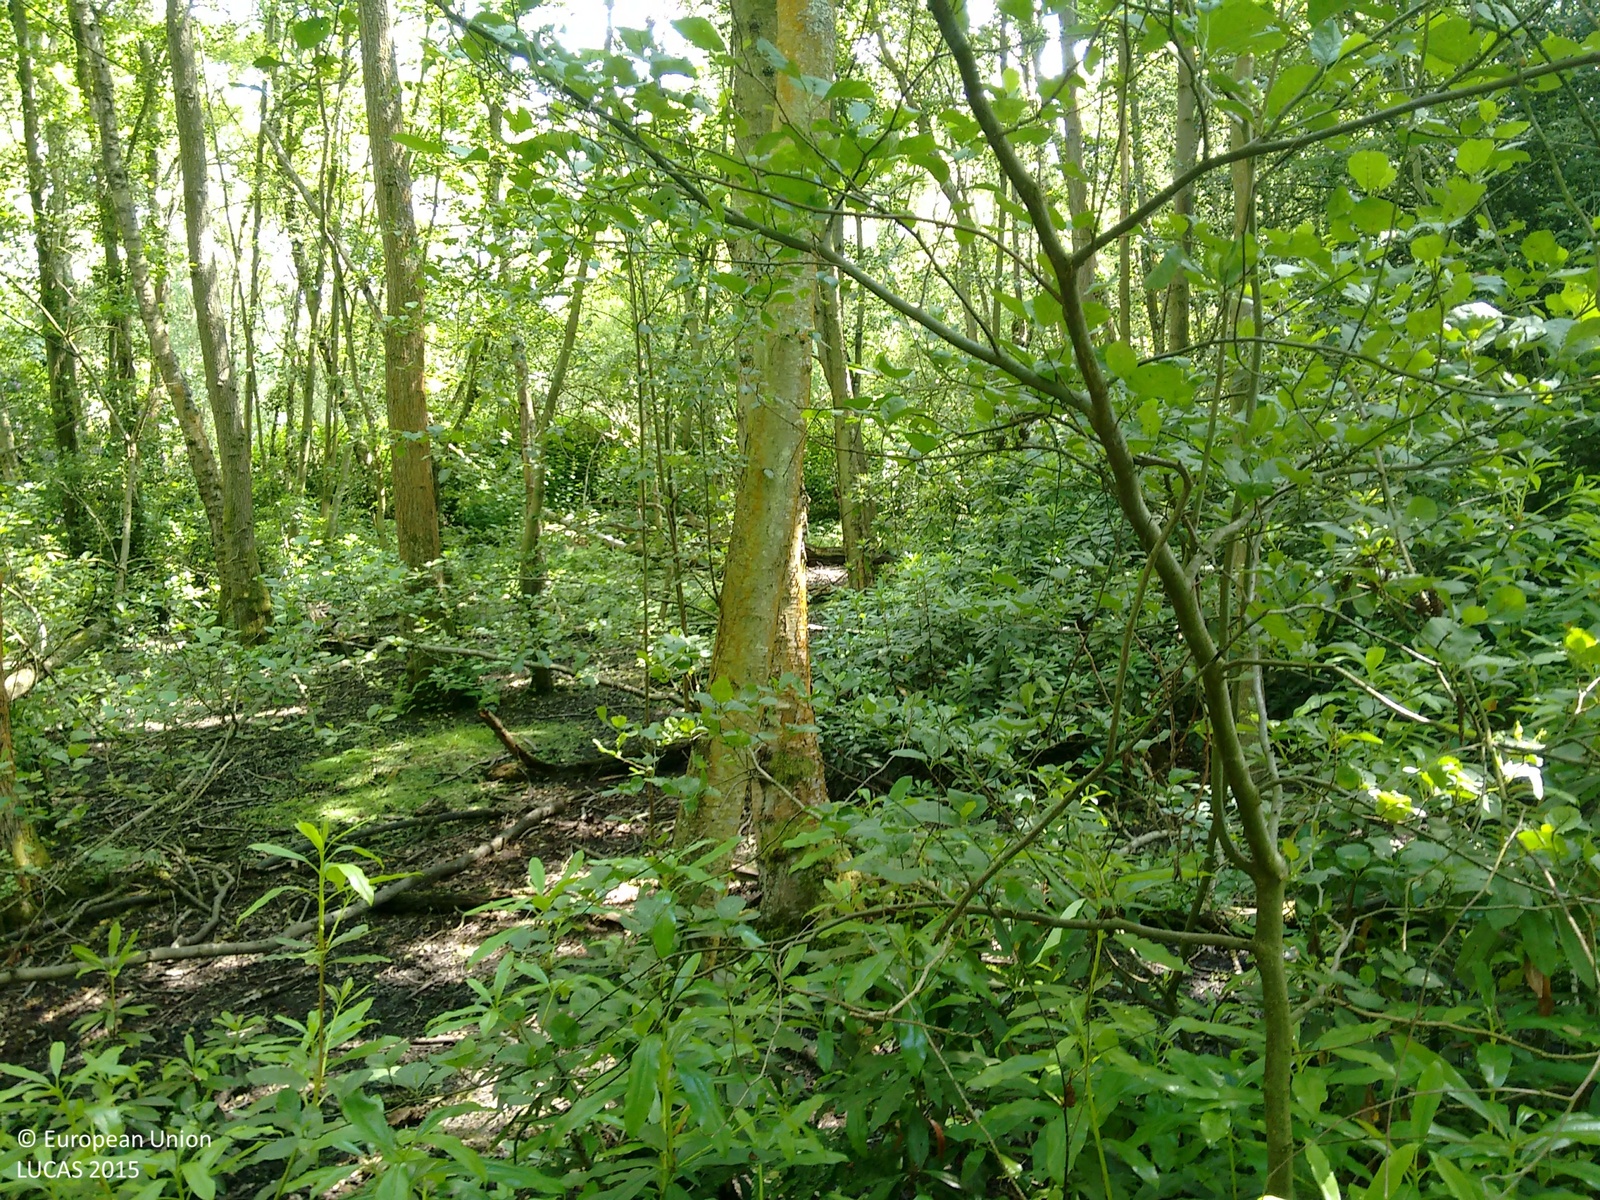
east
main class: Woodland
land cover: Broadleaved woodland
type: mesophytic deciduous forest
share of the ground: > 75 %
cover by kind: broadleaved forest trees 75 %, shrubs 25 %
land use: Semi-natural and natural areas not in use
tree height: > 5 m
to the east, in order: Broadleaved woodland; Grassland without tree/shrub cover; Tracks; Broadleaved woodland; Grassland without tree/shrub cover; Broadleaved woodland; Grassland without tree/shrub cover
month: June
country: GB
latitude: 51.1294
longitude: -0.1081
